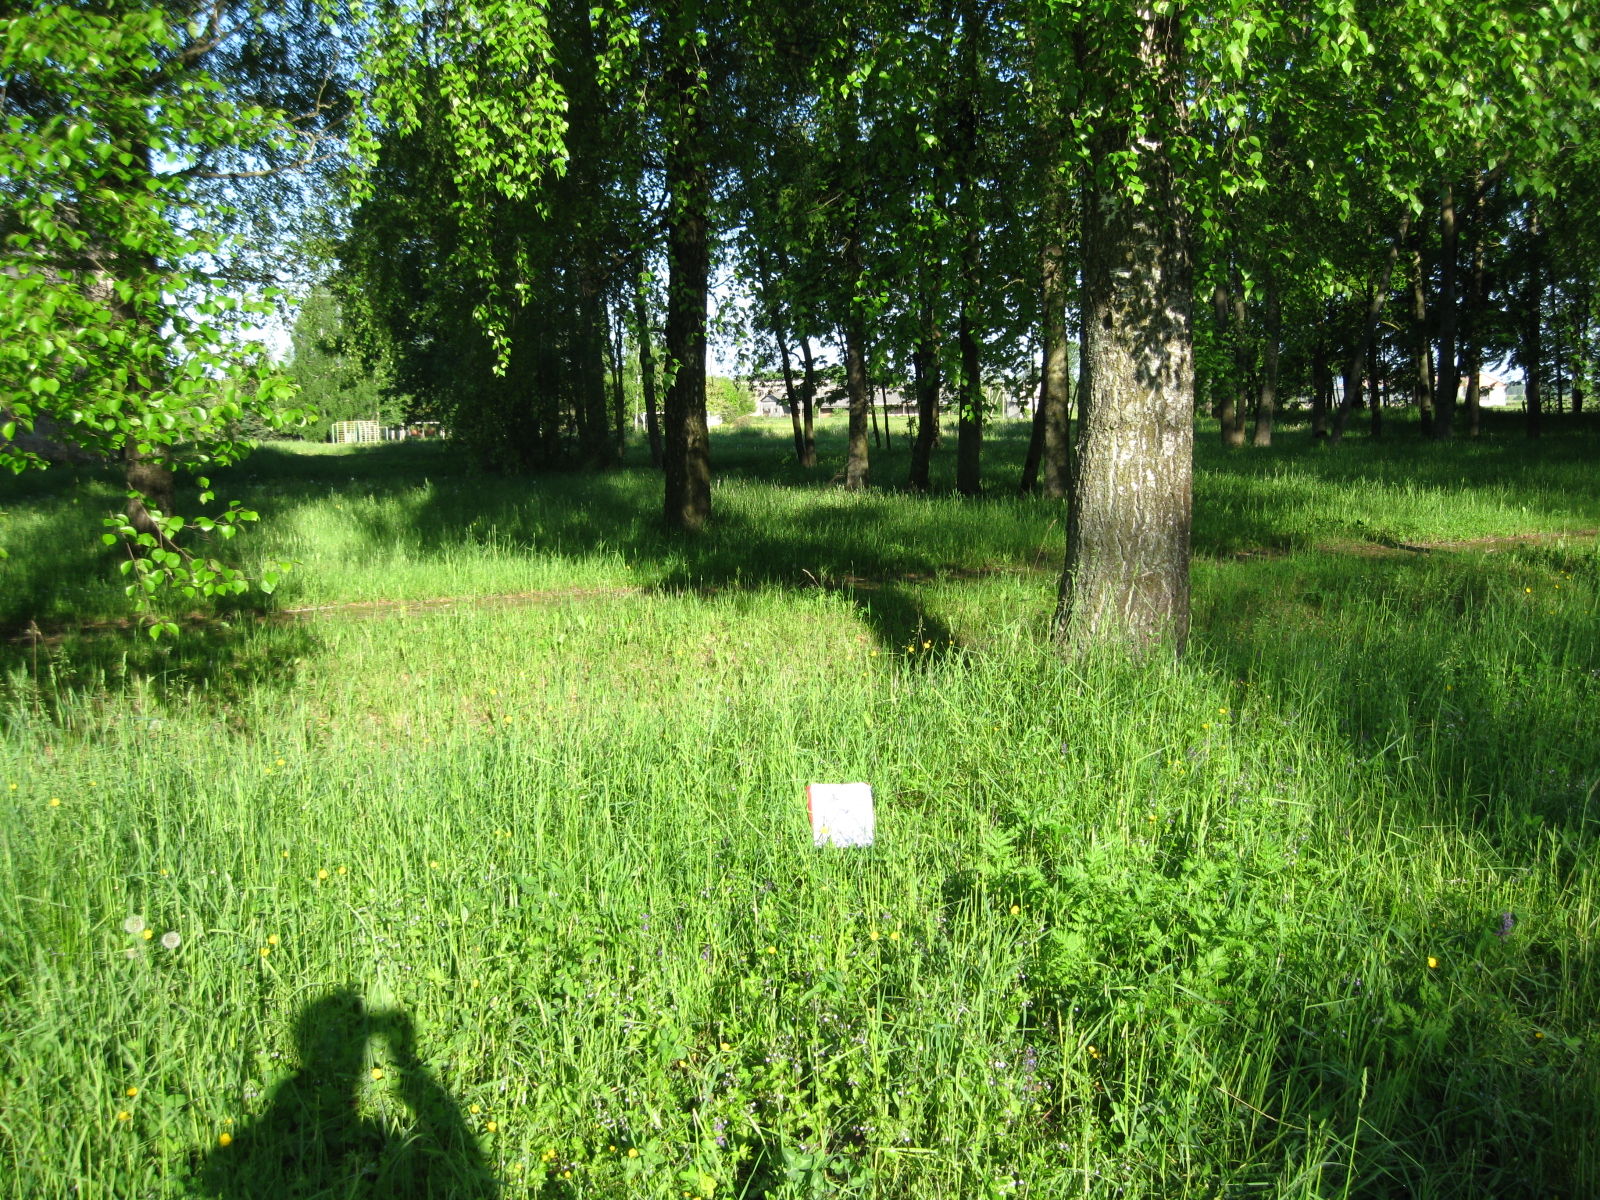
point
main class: Woodland
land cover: Broadleaved woodland
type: non-riverine alder, birch or aspen forest
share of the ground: 50 - 75 %
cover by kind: broadleaved forest trees 55 %, herbaceous plants 45 %
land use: Amenities, museums, leisure
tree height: > 5 m
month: May
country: LT
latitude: 55.9081
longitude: 24.8066
